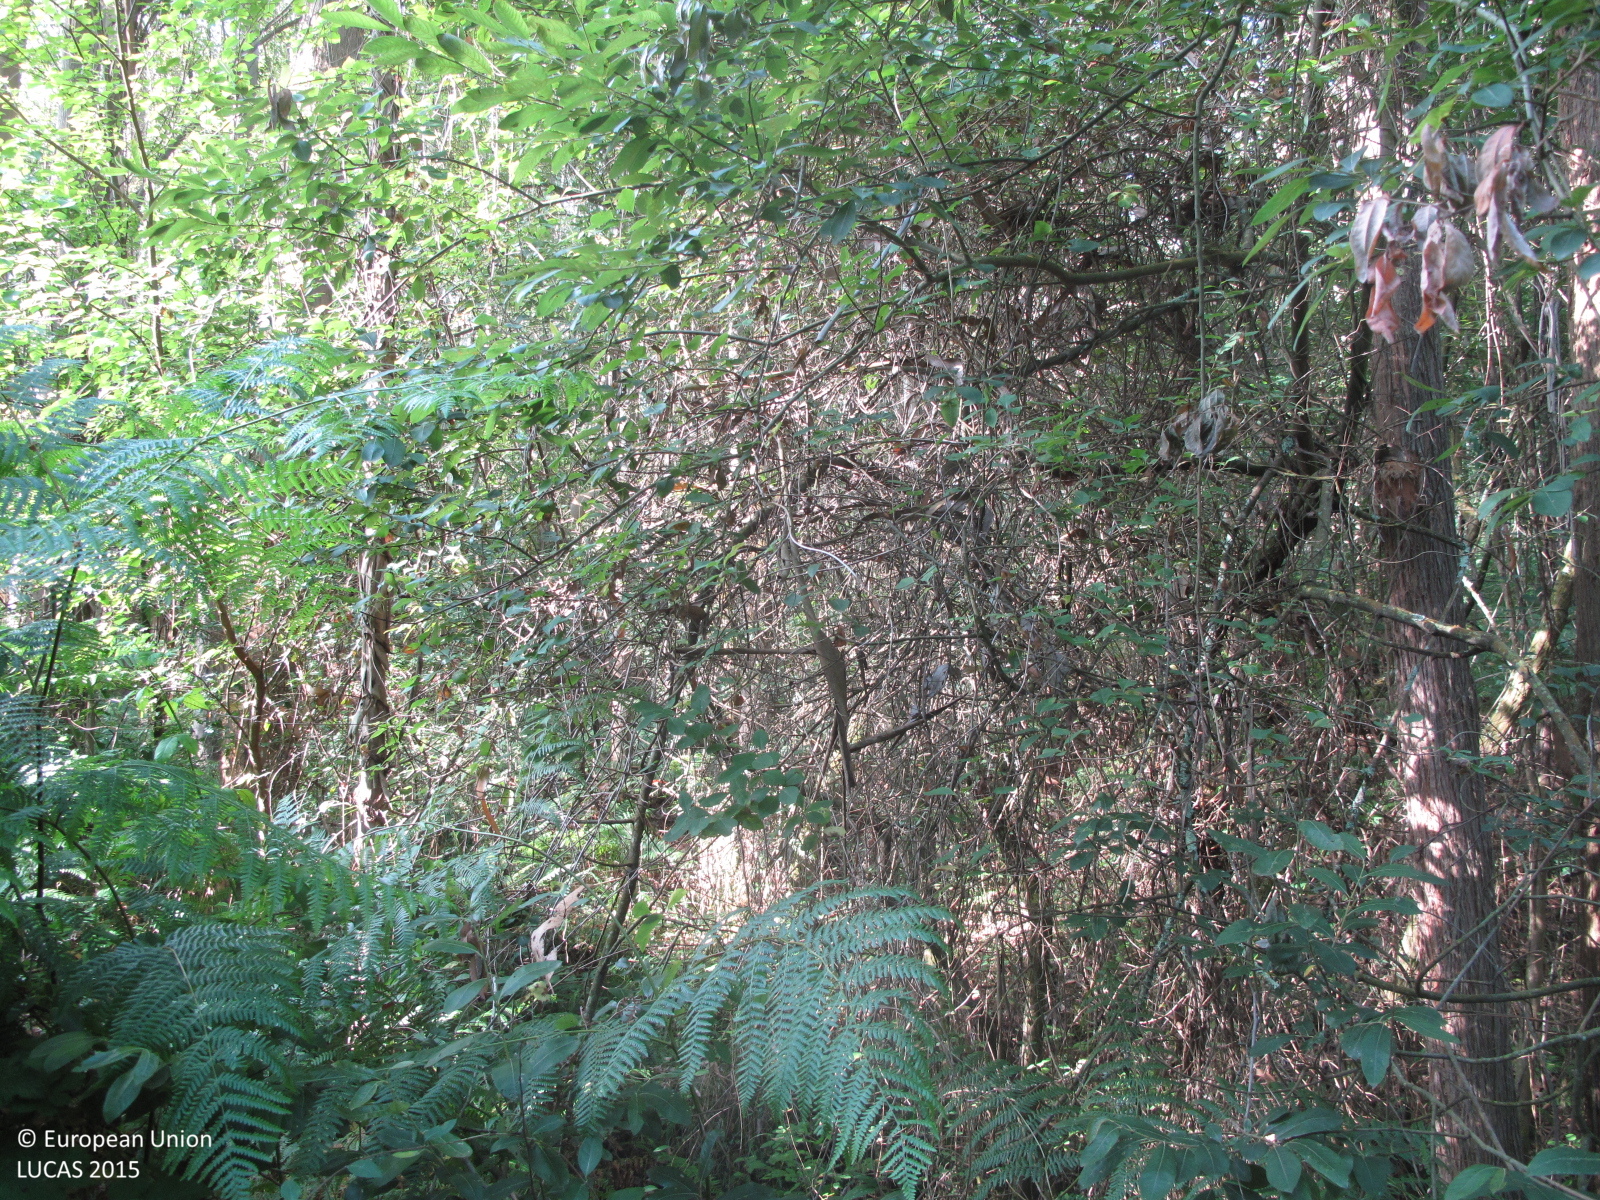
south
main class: Woodland
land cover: Broadleaved woodland
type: exotic forest
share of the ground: 50 - 75 %
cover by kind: broadleaved forest trees 60 %, shrubs 20 %, herbaceous plants 20 %
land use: Forestry
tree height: > 5 m
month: July
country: ES
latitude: 43.2864
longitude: -8.1529
